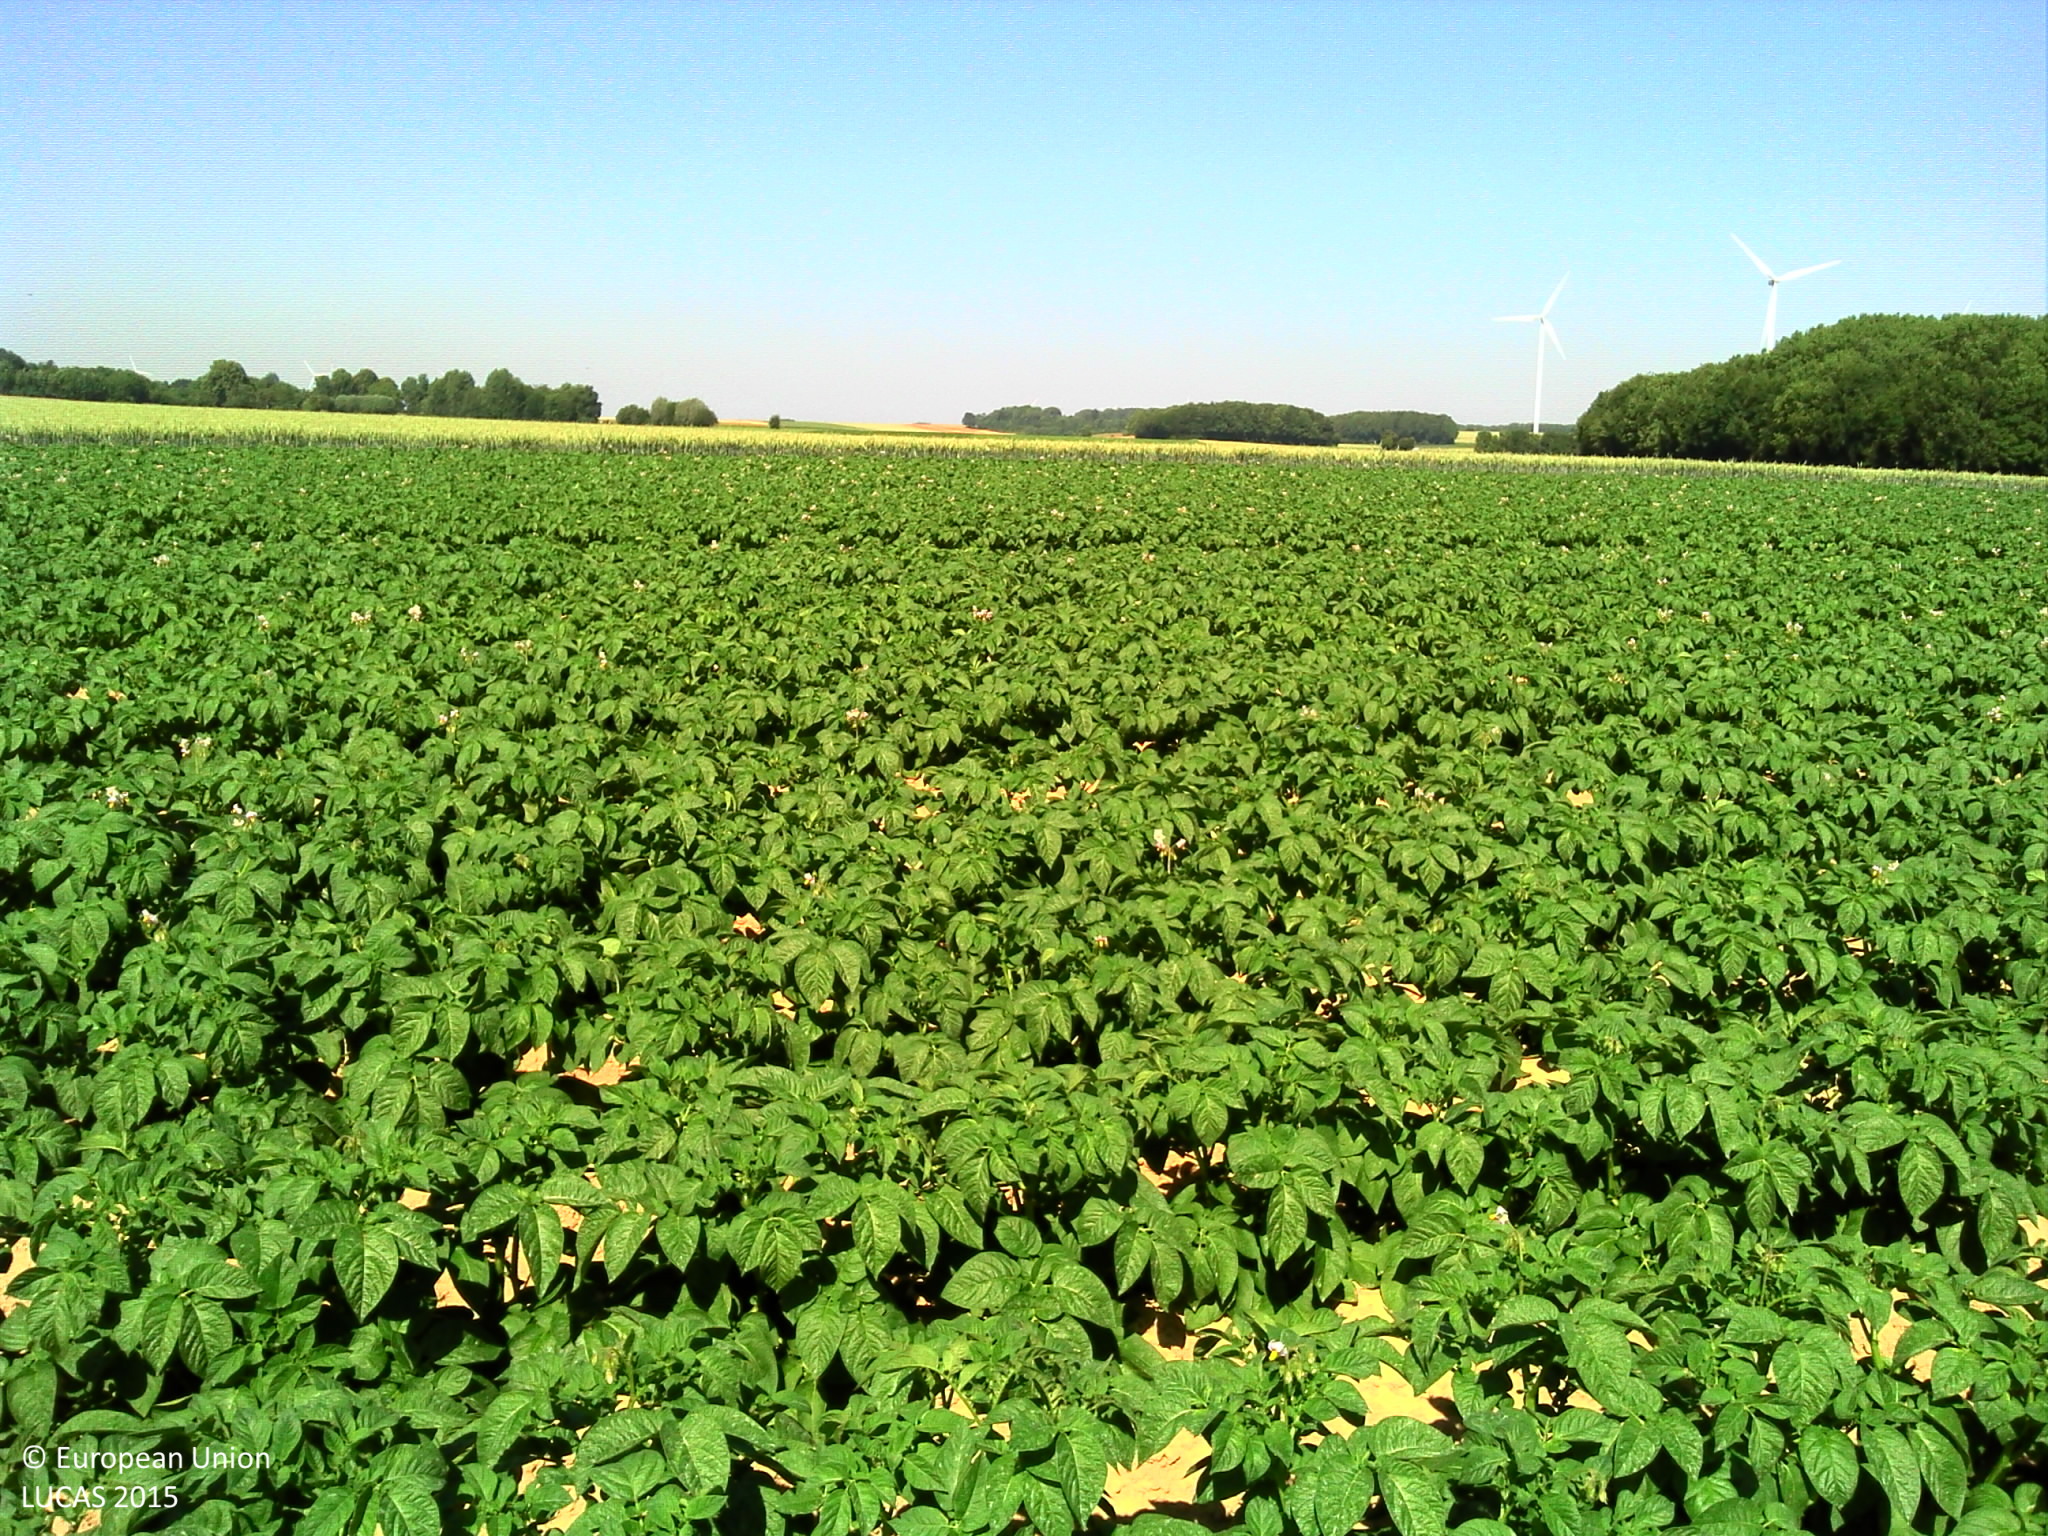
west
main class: Cropland
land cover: Potatoes
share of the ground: > 75 %
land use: Agriculture (excluding fallow land and kitchen gardens)
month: June
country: FR
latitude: 50.3343
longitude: 2.4992
